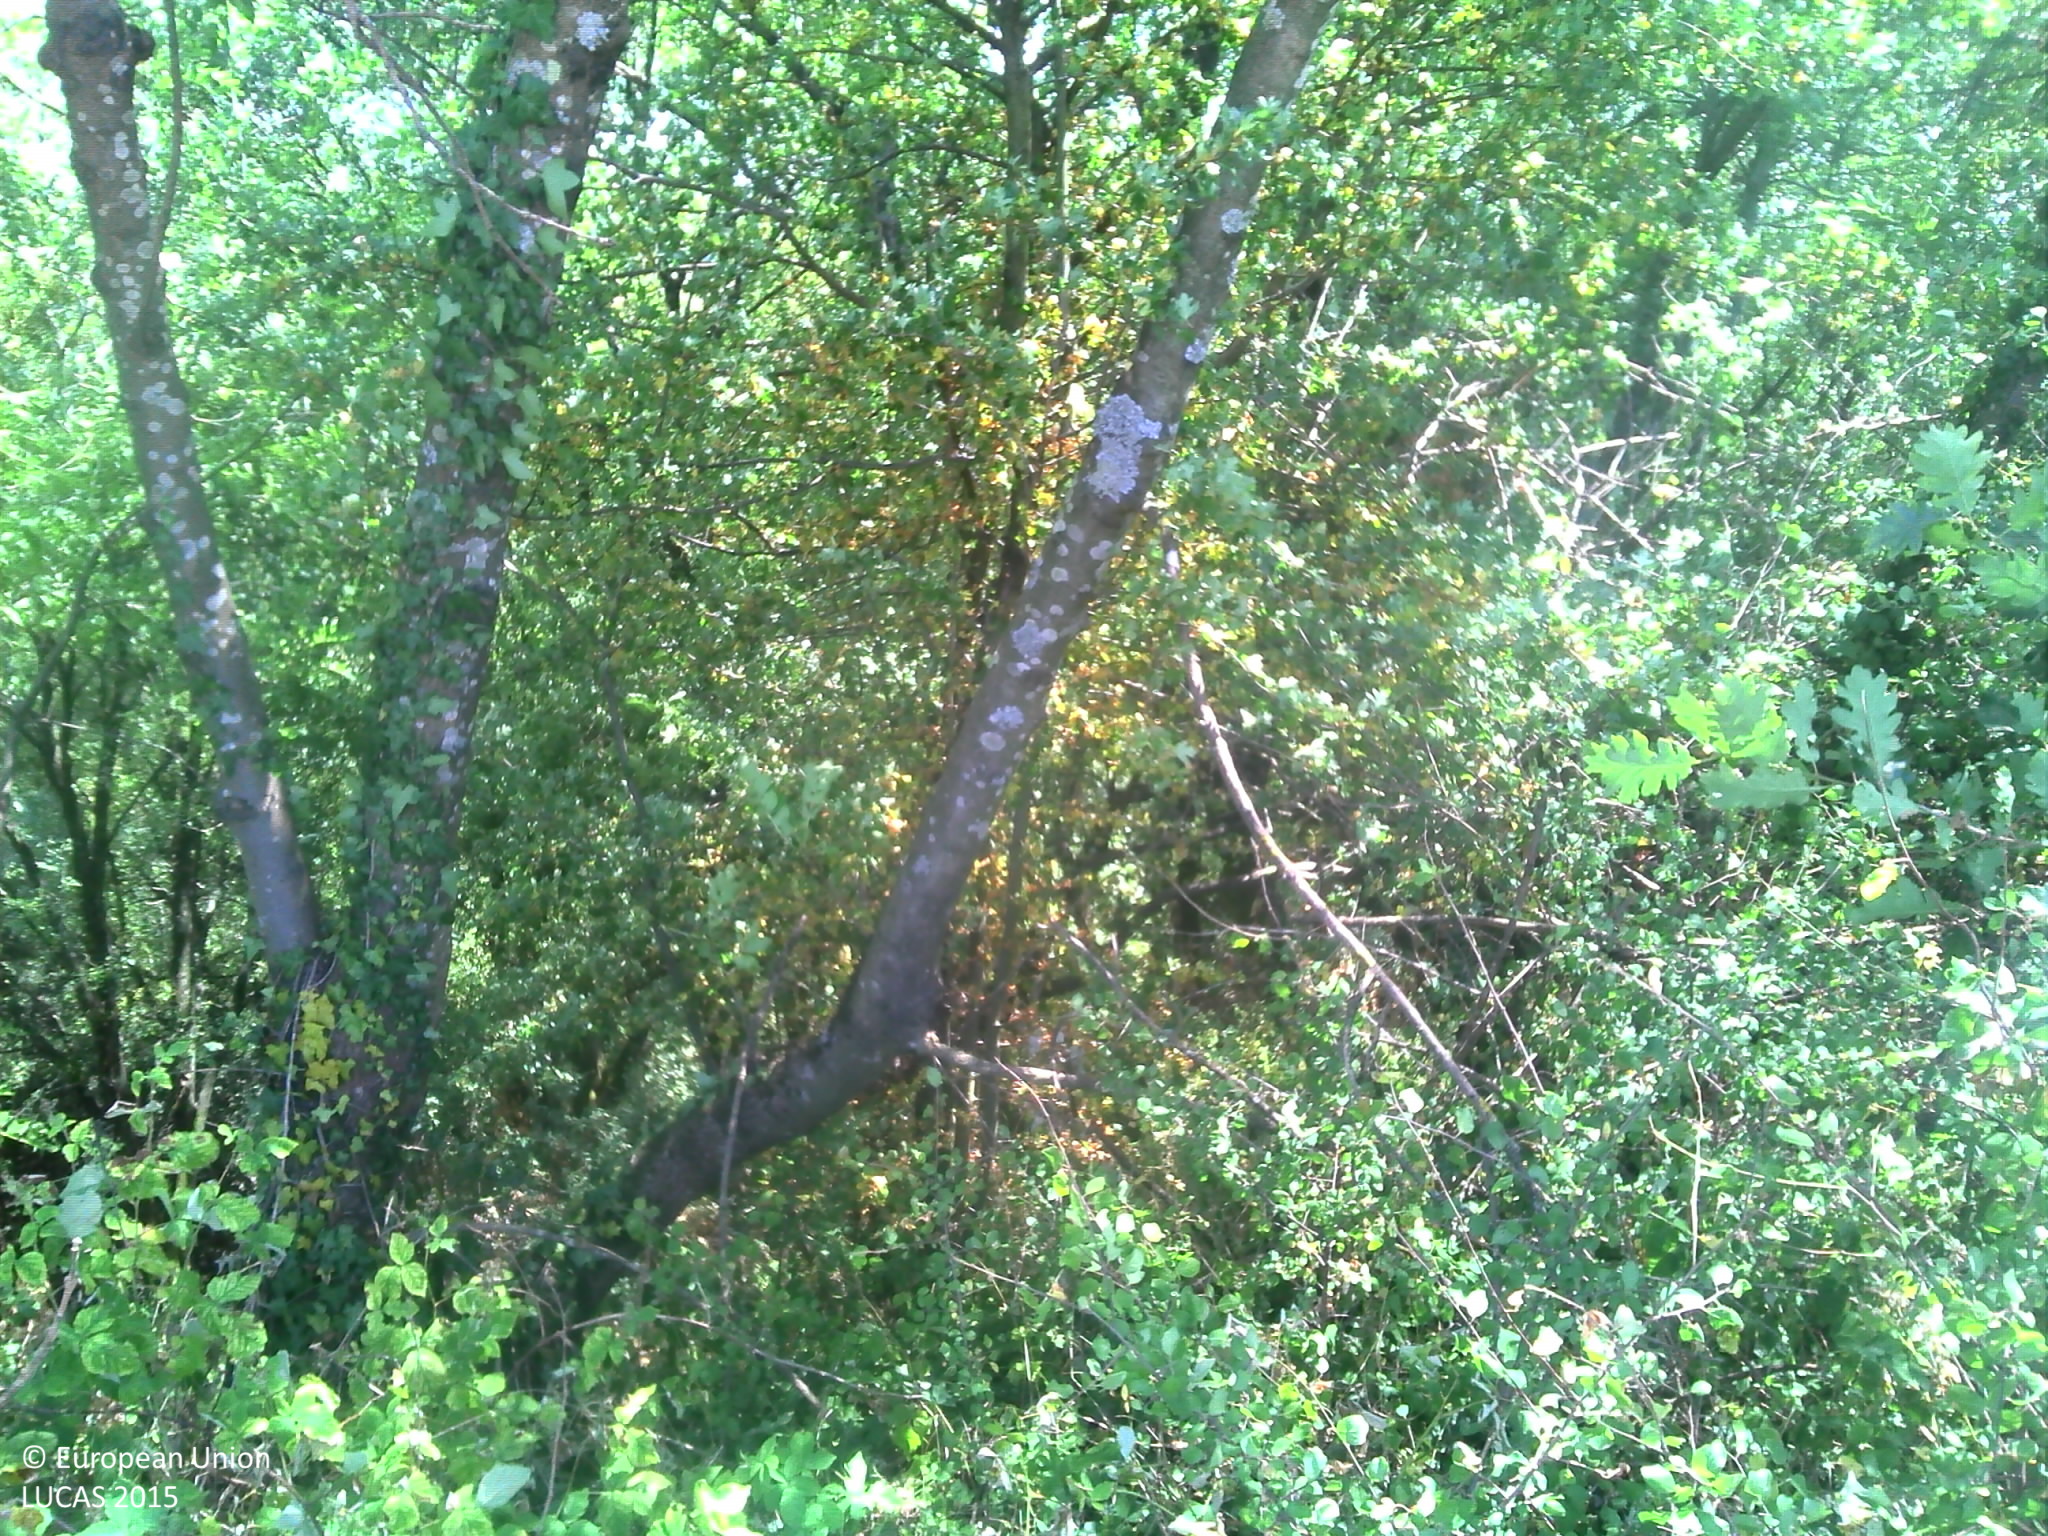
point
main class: Woodland
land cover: Broadleaved woodland
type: mesophytic deciduous forest
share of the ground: > 75 %
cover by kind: broadleaved forest trees 90 %, herbaceous plants 10 %
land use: Forestry
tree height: > 5 m
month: July
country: FR
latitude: 45.5601
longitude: 4.8668
